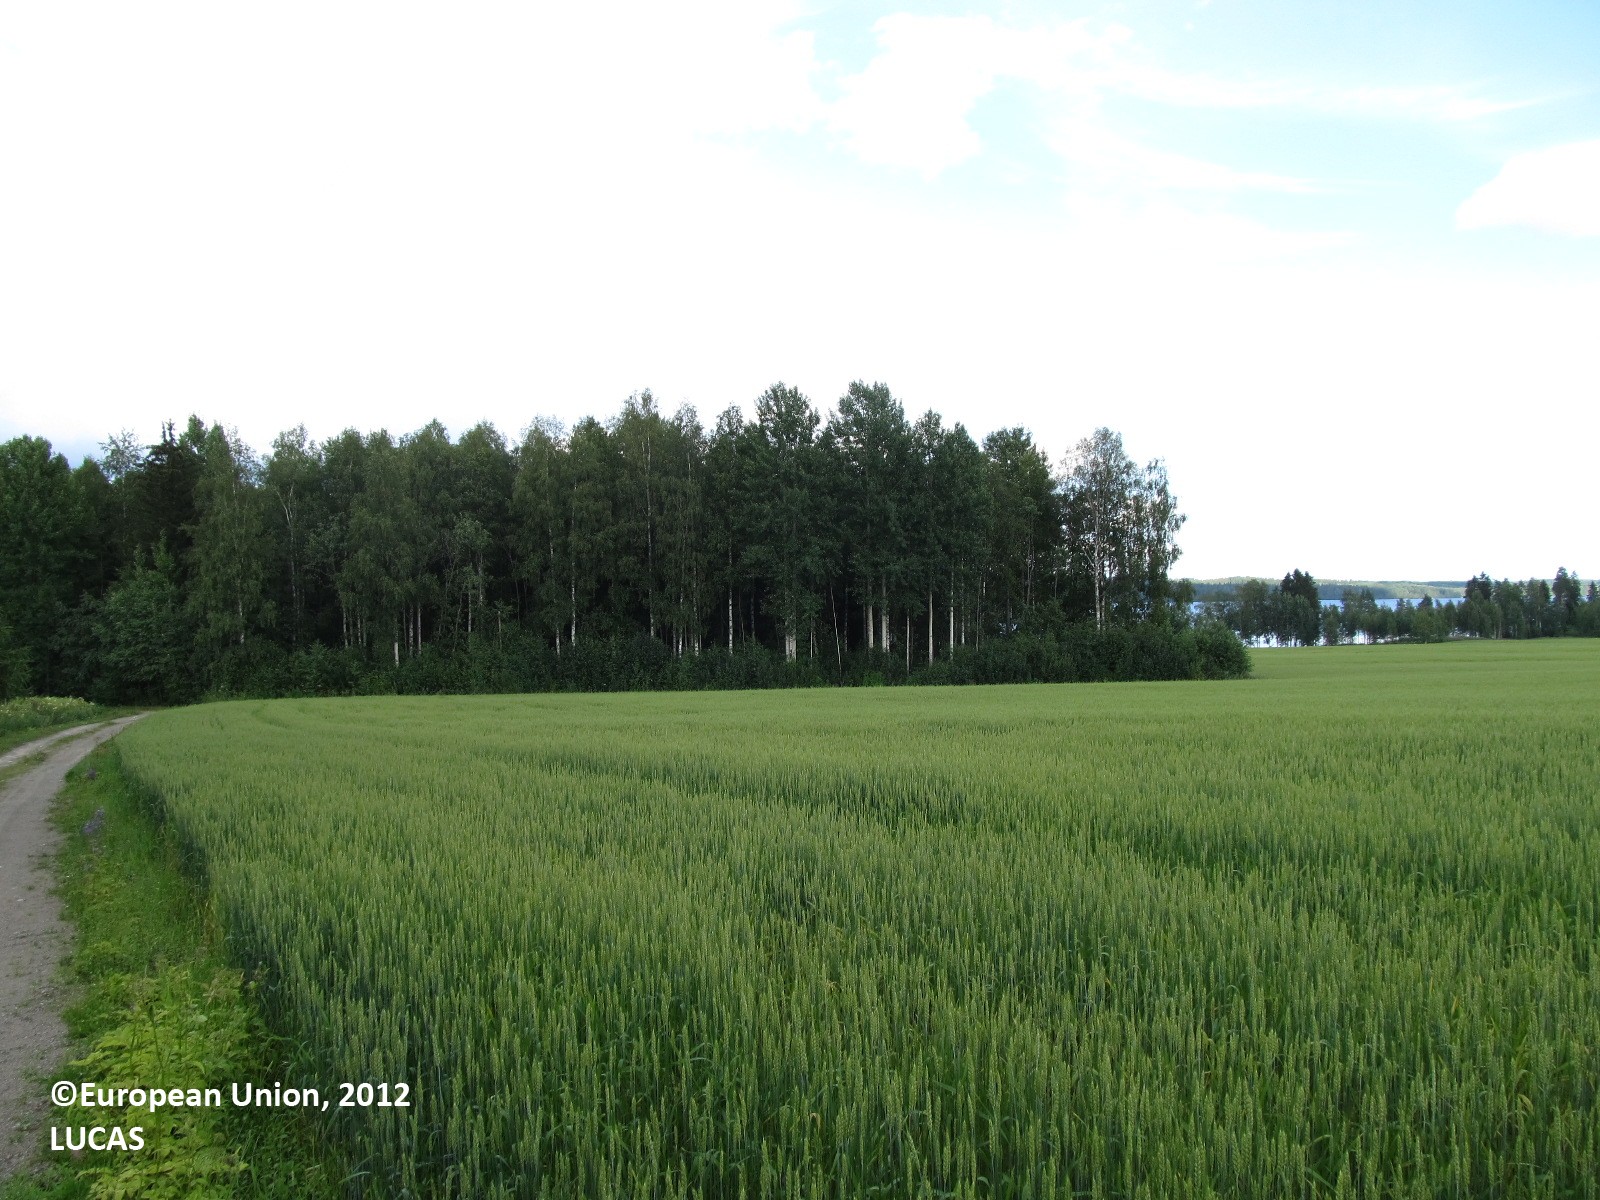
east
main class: Cropland
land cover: Common wheat
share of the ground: > 75 %
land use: Agriculture (excluding fallow land and kitchen gardens)
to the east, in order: Common wheat
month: July
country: FI
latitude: 62.0257
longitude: 28.0586
